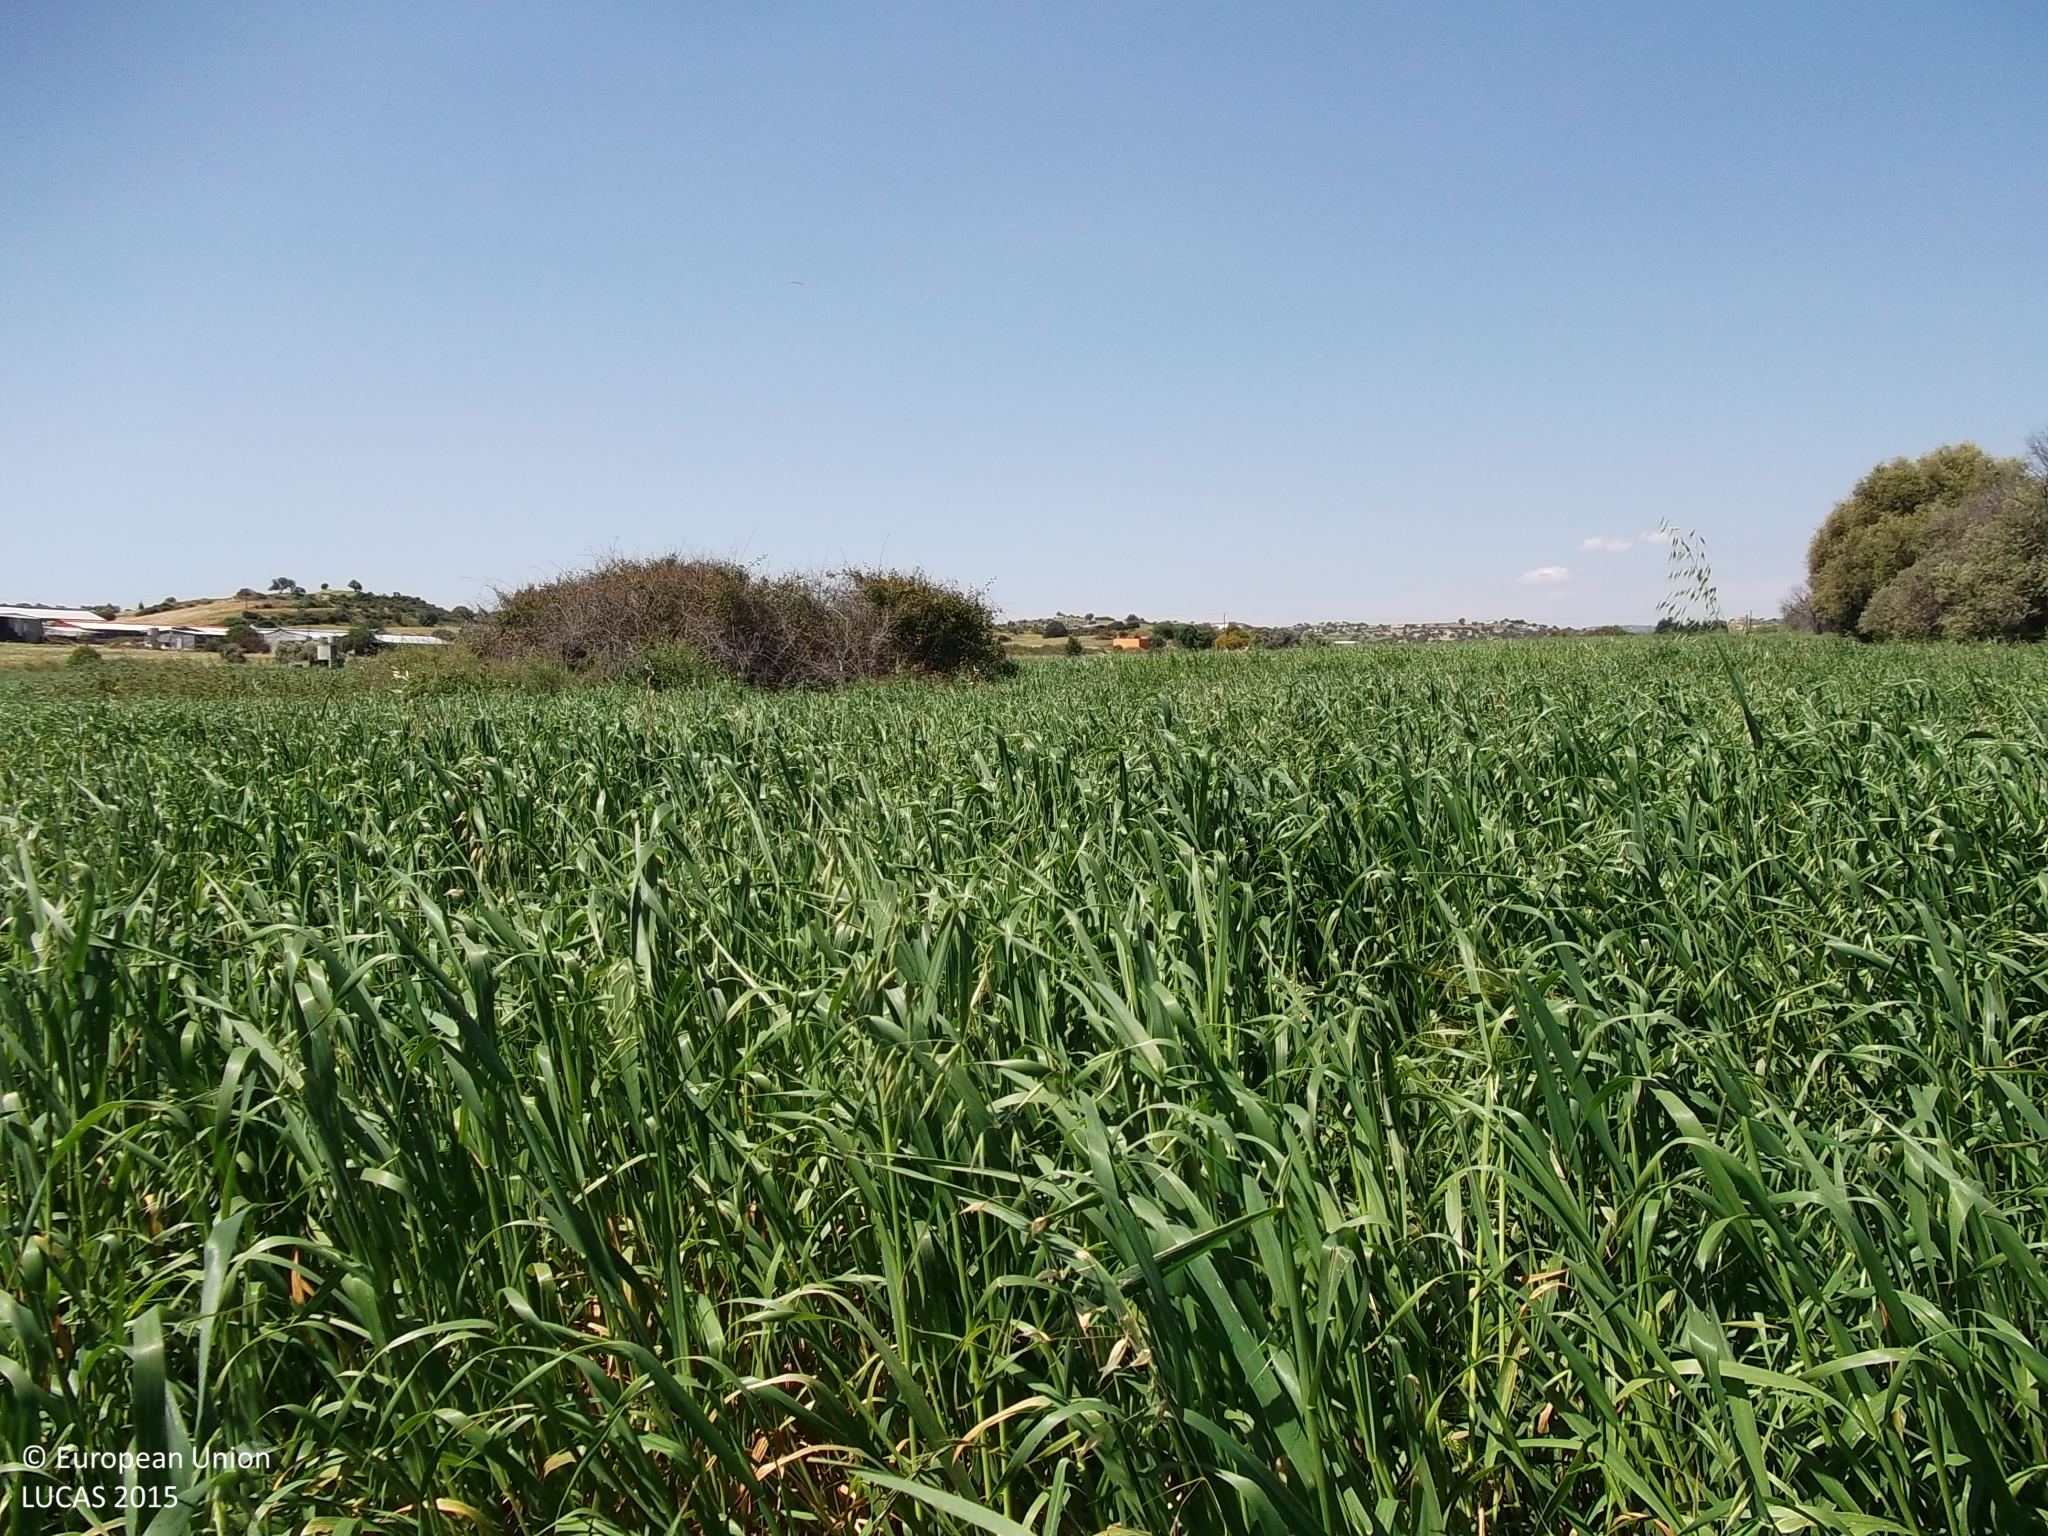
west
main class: Cropland
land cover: Oats
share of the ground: > 75 %
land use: Agriculture (excluding fallow land and kitchen gardens)
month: April
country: CY
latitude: 34.8179
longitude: 33.4160
